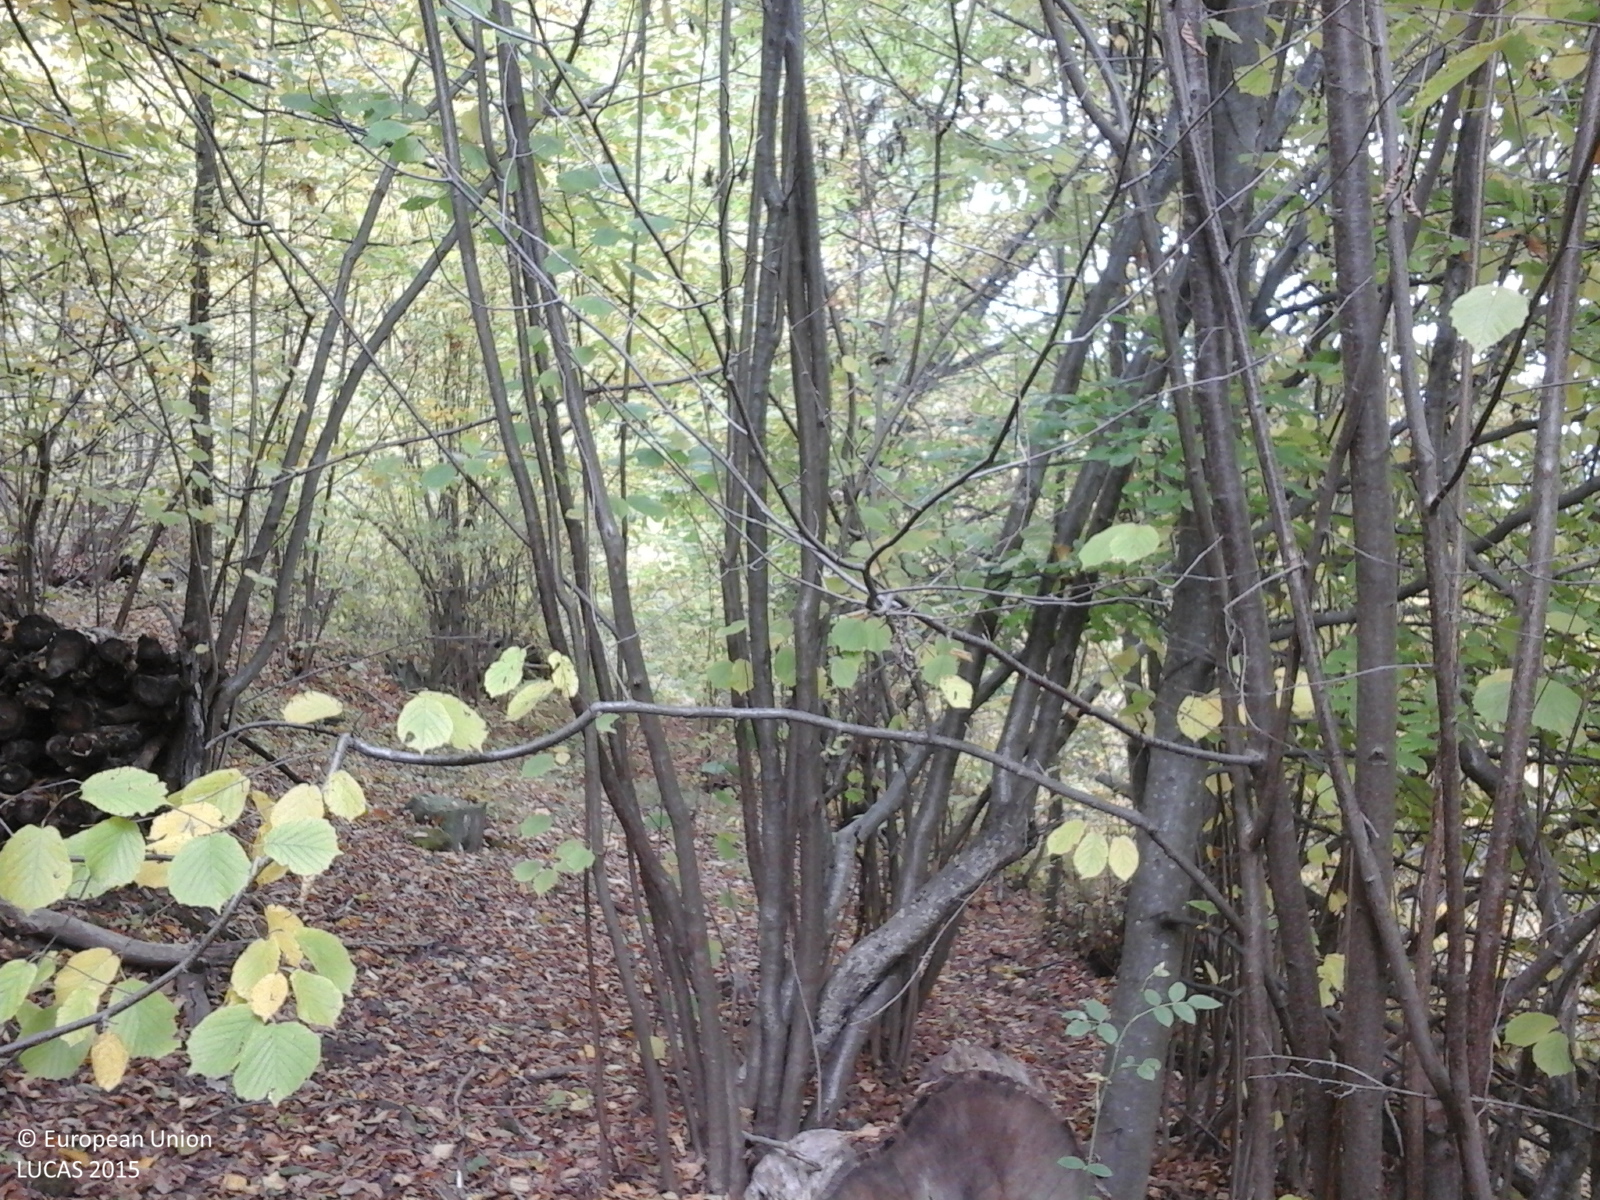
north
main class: Woodland
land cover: Broadleaved woodland
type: beech forest
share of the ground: > 75 %
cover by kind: broadleaved forest trees 100 %
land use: Forestry
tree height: > 5 m
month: October
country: RO
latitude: 46.4546
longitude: 25.4041
